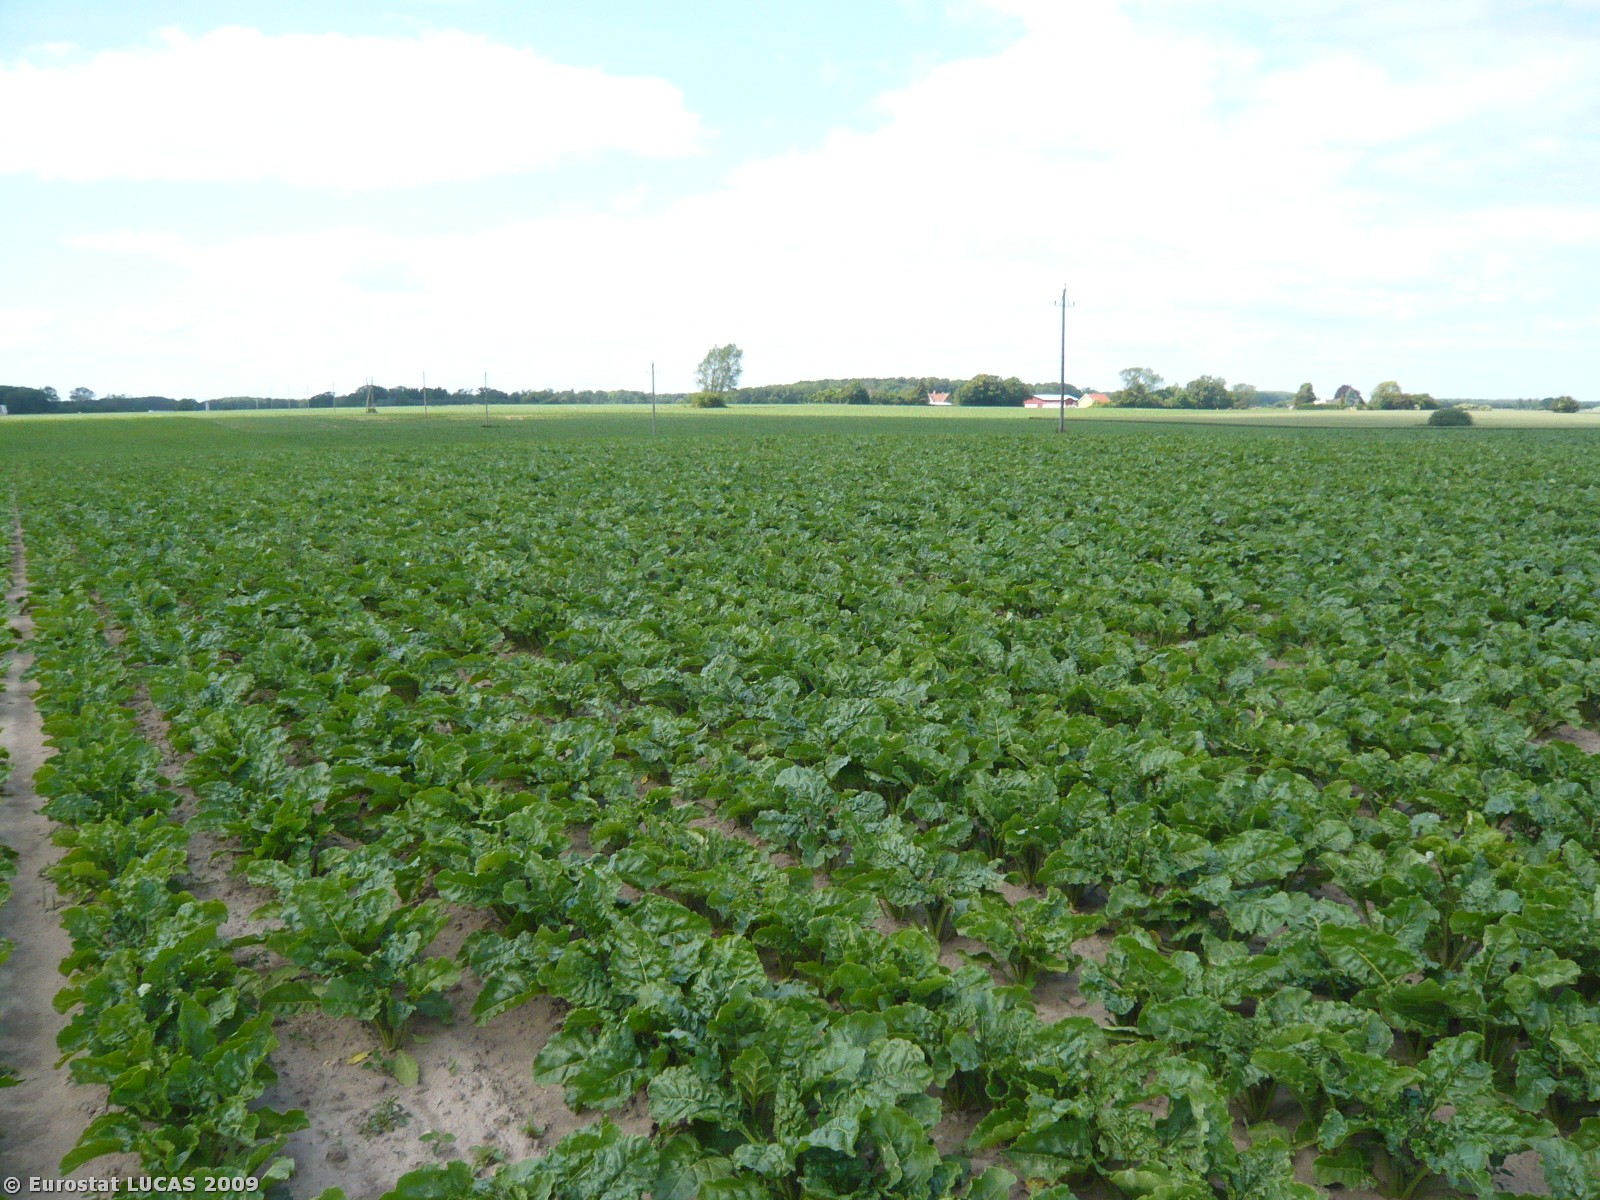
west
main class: Cropland
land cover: Sugar beet
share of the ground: > 75 %
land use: Agriculture (excluding fallow land and kitchen gardens)
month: June
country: DK
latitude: 54.8869
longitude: 11.2930
